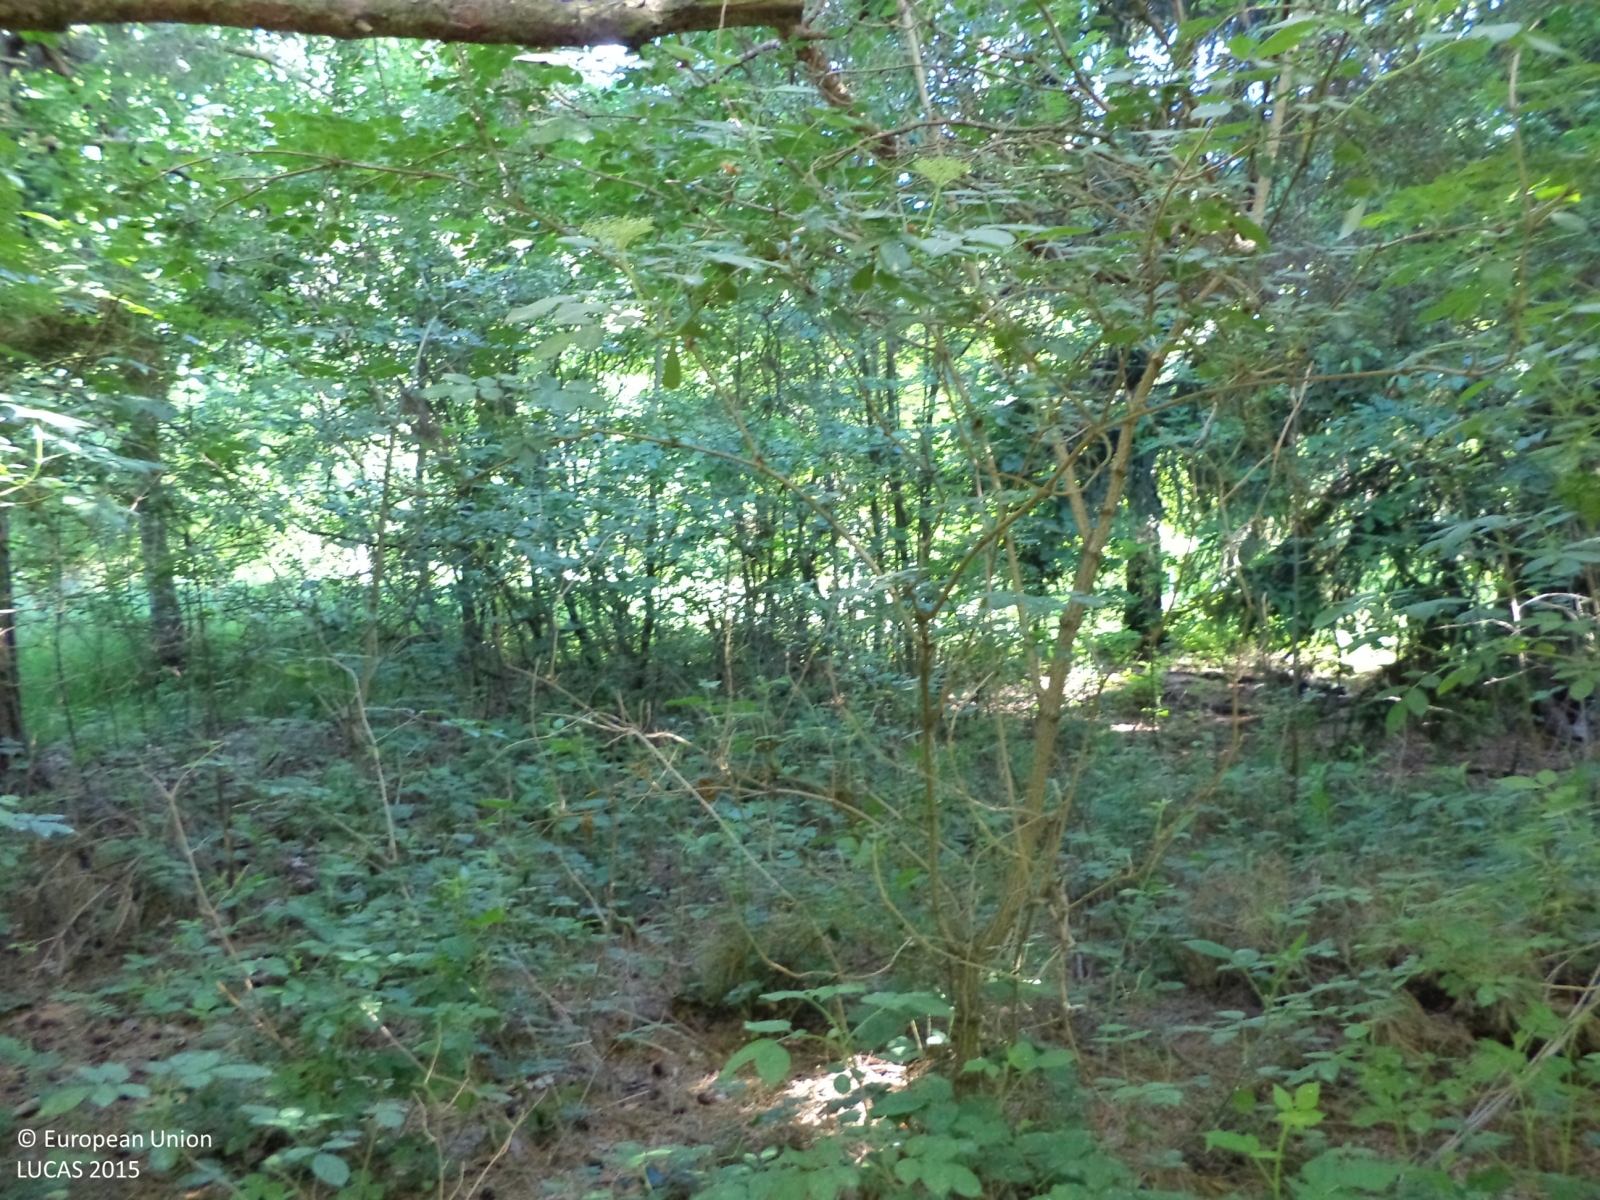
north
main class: Grassland
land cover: Spontaneously vegetated surfaces
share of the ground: > 75 %
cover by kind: herbaceous plants 95 %, shrubs 5 %
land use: Fallow land
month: June
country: CZ
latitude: 49.6445
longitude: 14.9465
